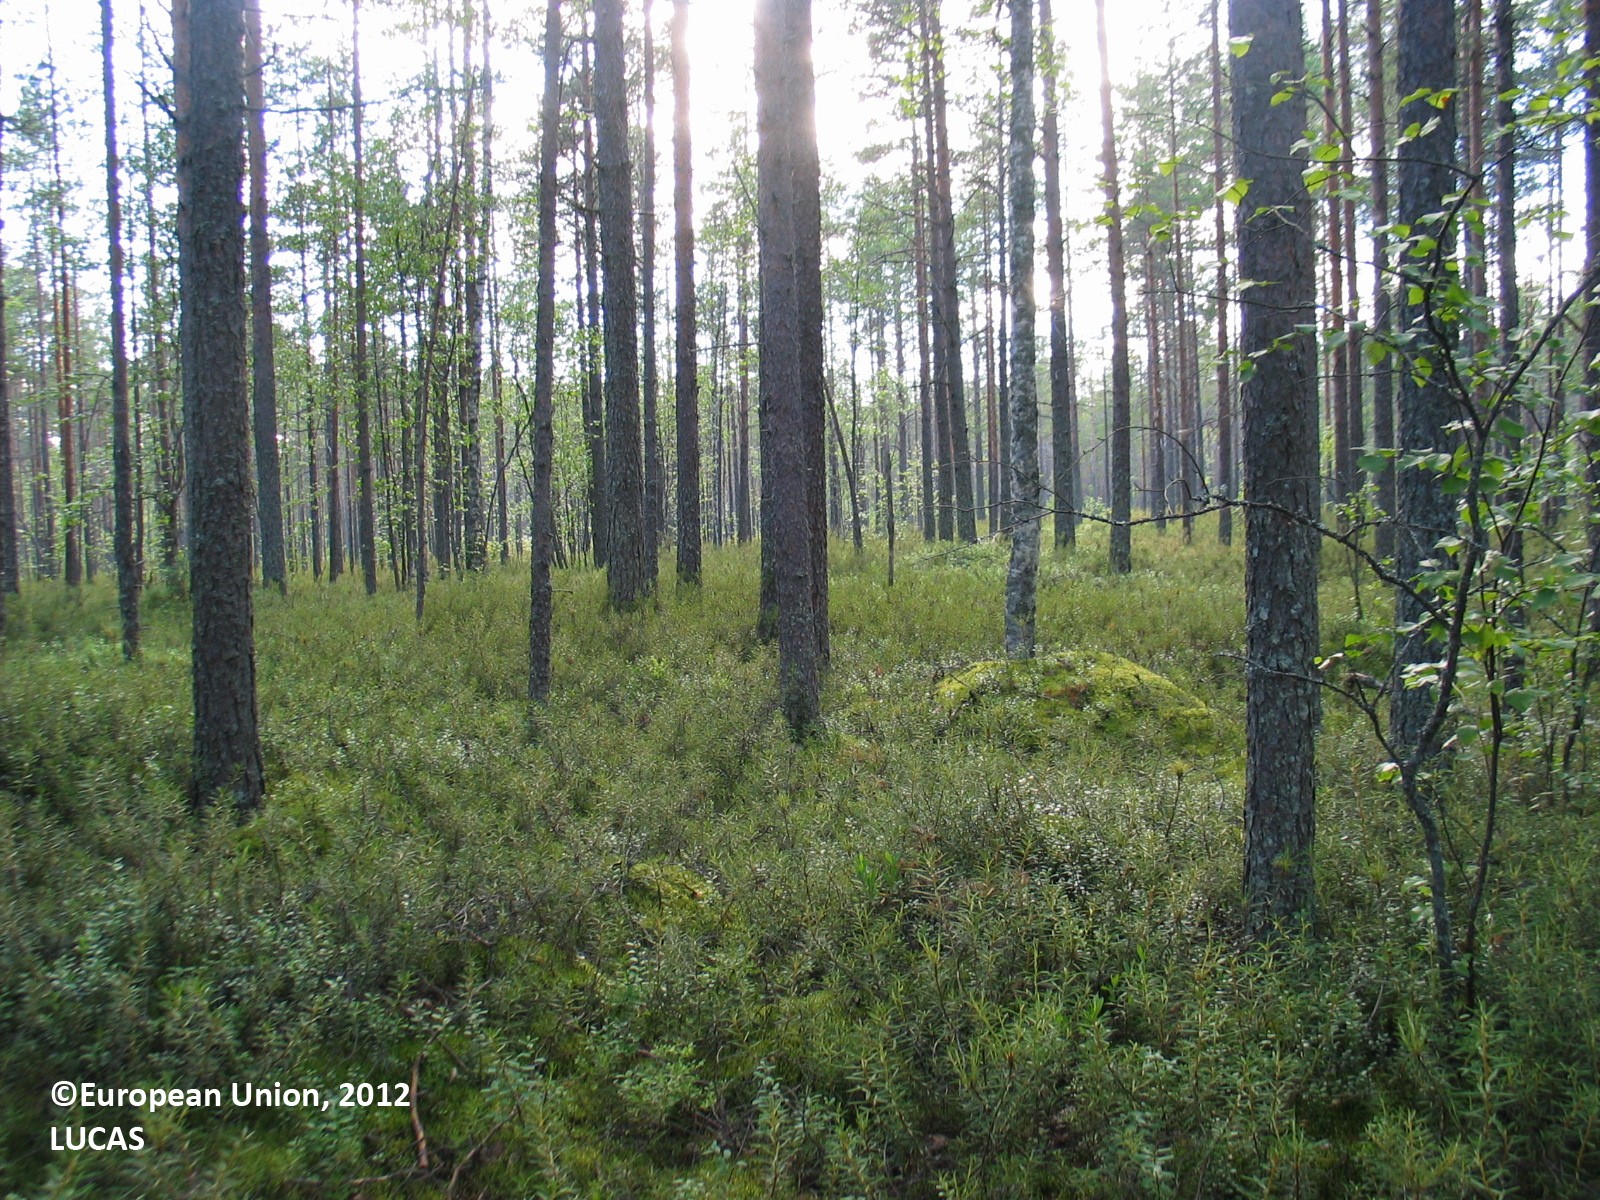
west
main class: Woodland
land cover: Pine dominated coniferous woodland
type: mire and swamp forests
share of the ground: 50 - 75 %
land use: Forestry
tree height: > 5 m
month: July
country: FI
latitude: 64.6559
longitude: 26.5070
